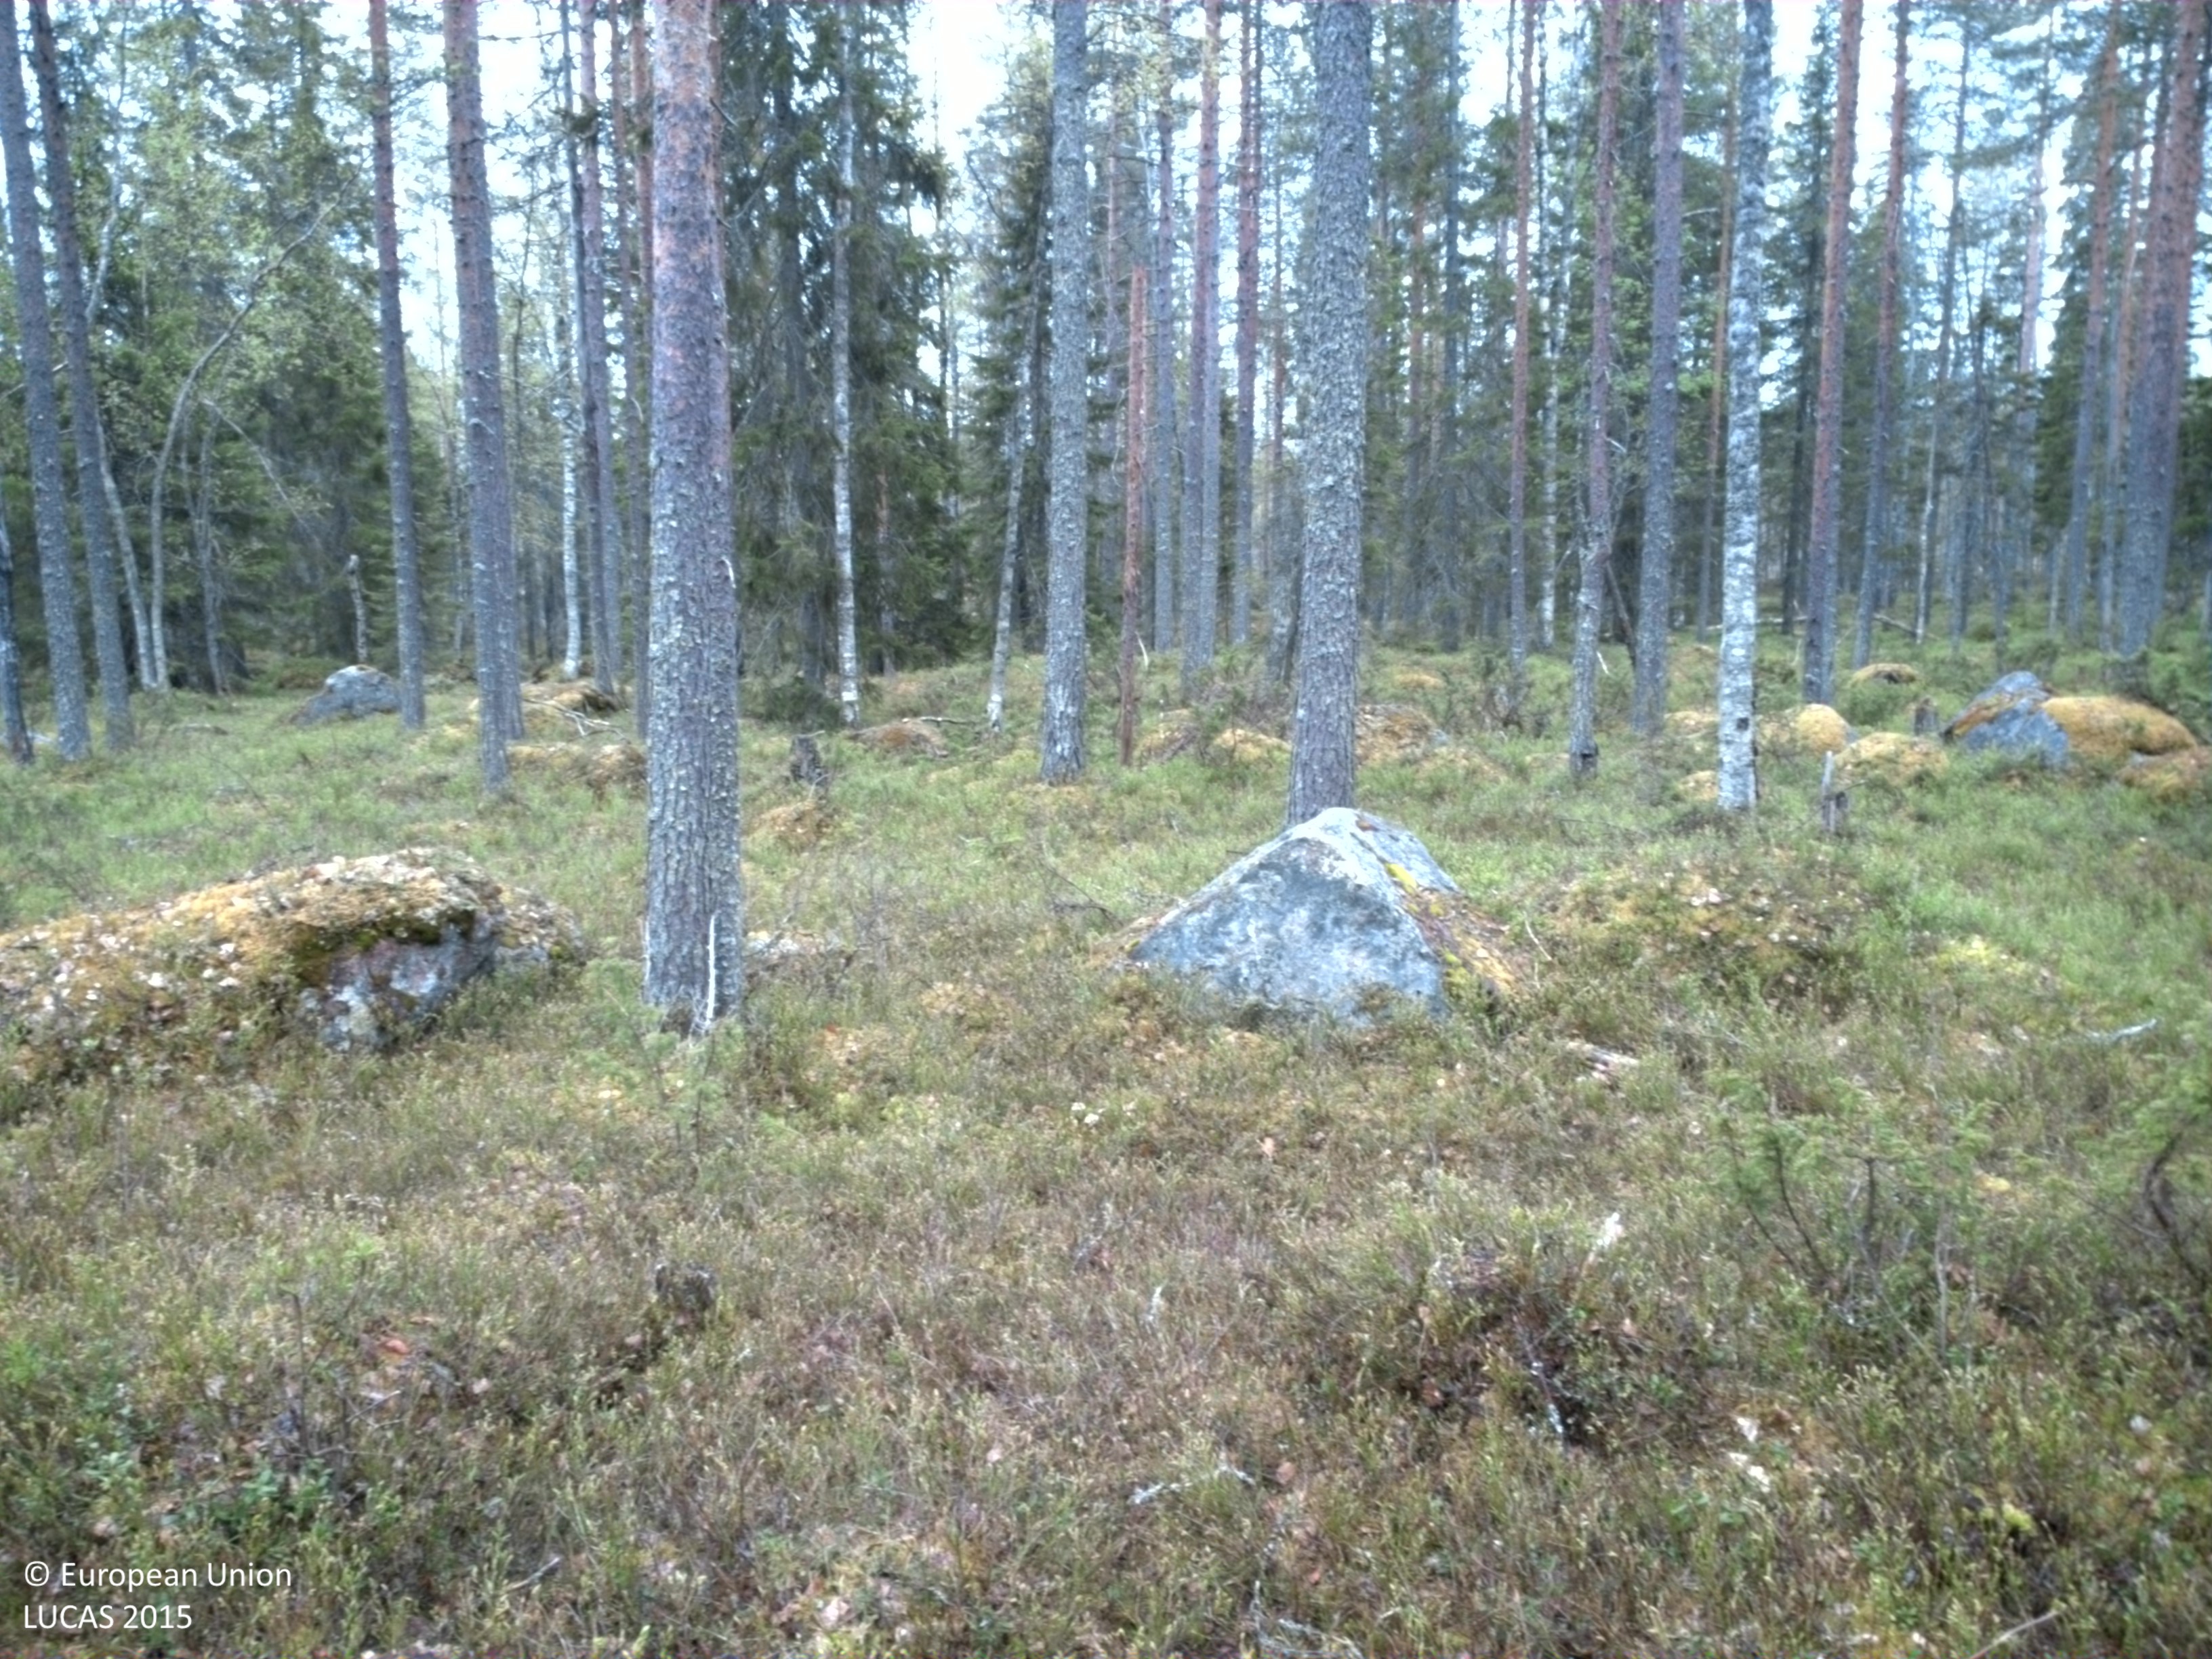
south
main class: Woodland
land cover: Pine dominated coniferous woodland
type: boreal forest
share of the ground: 50 - 75 %
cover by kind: coniferous forest trees 65 %, shrubs 30 %, broadleaved forest trees 5 %
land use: Forestry
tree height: > 5 m
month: May
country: SE
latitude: 66.0388
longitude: 23.3386
